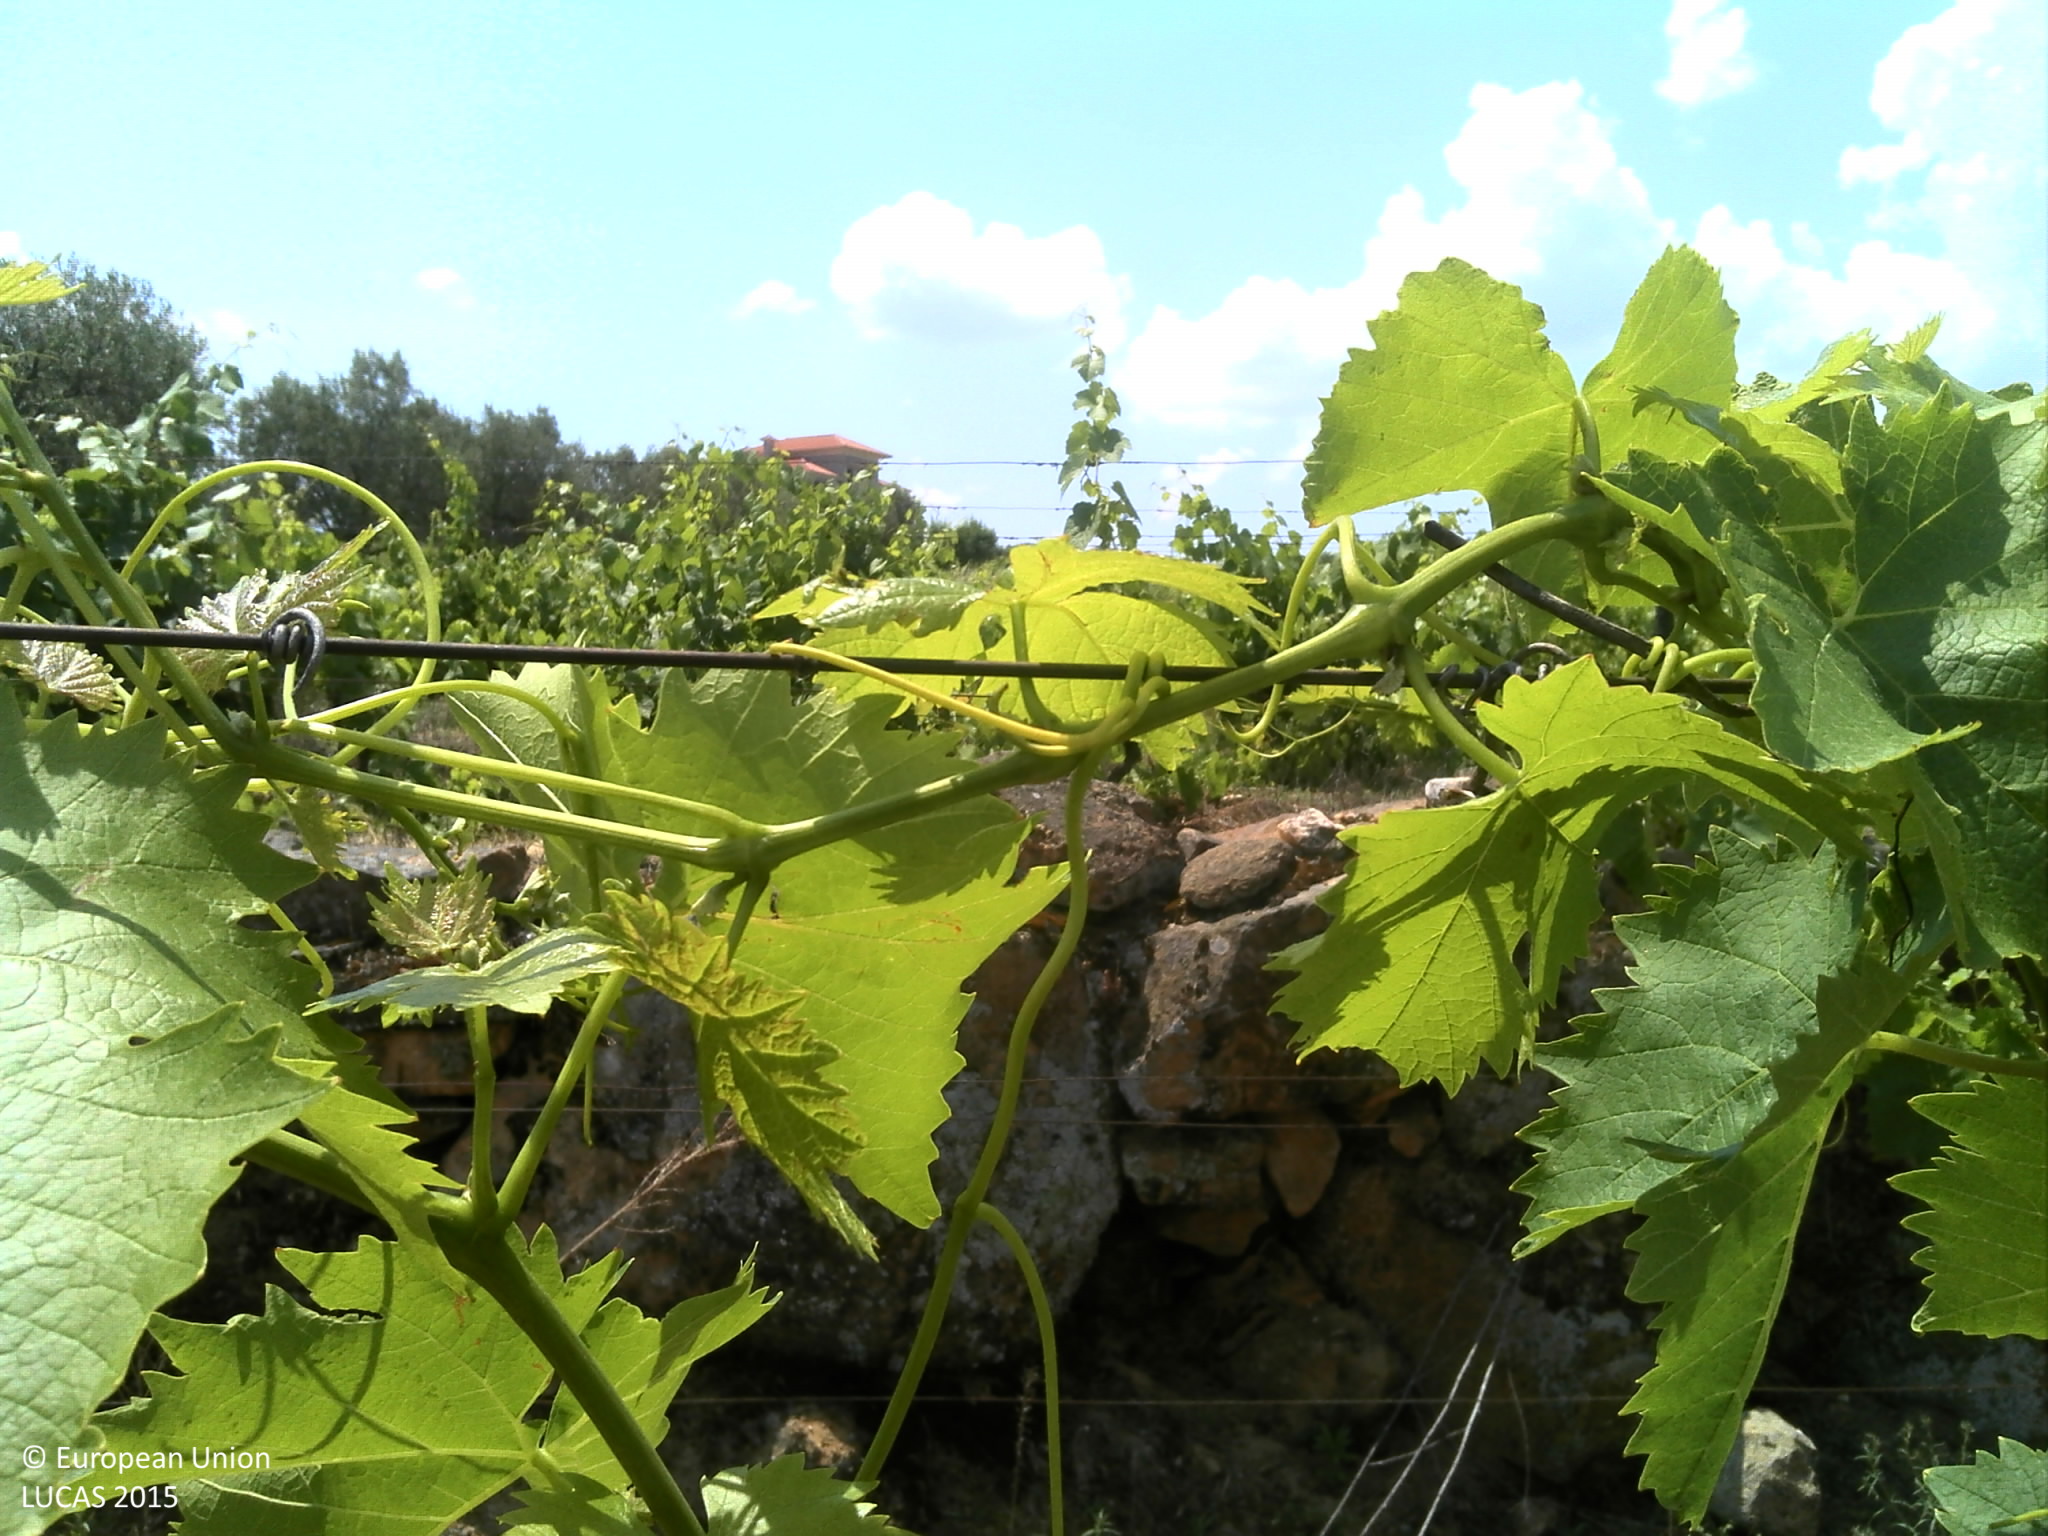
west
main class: Cropland
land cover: Vineyards
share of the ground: 10 - 25 %
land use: Agriculture (excluding fallow land and kitchen gardens)
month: June
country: PT
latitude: 41.2697
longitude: -7.4676
